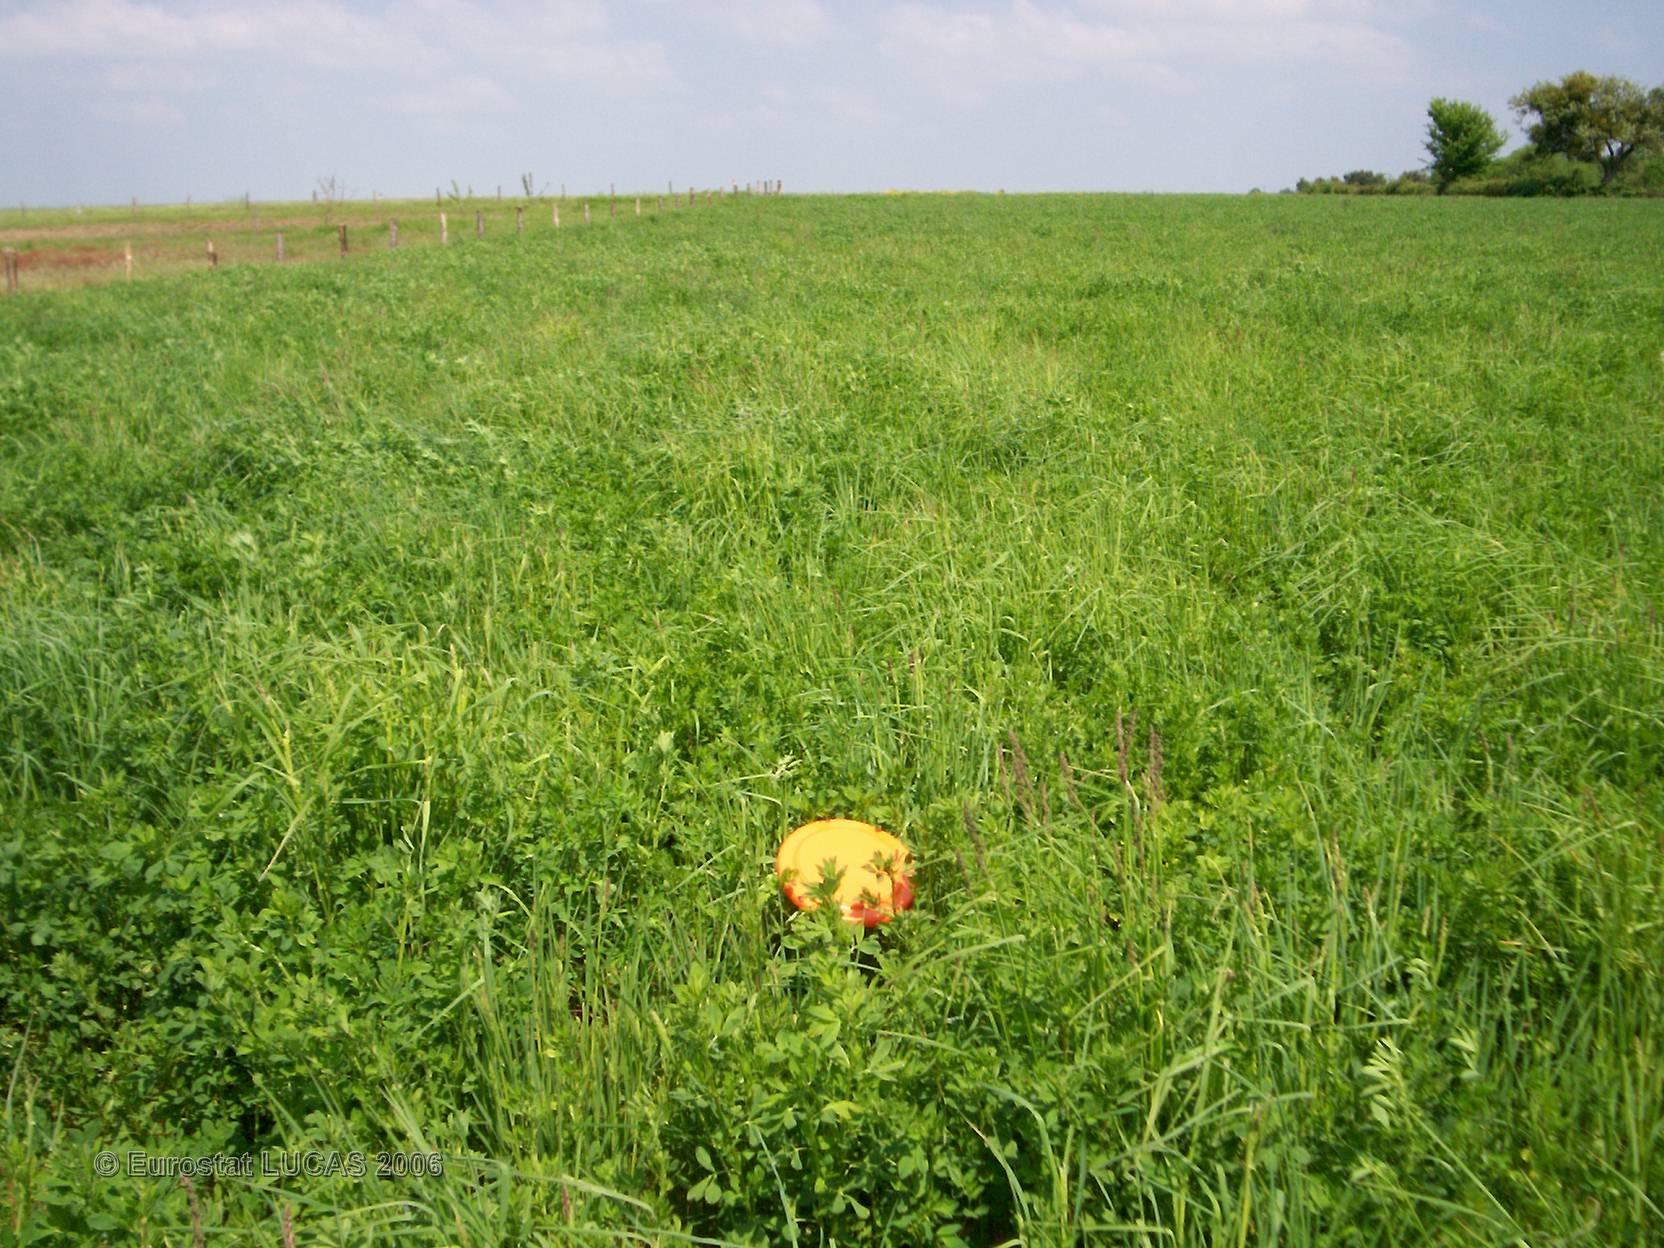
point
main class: Cropland
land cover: Lucerne
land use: Agriculture (excluding fallow land and kitchen gardens)
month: May
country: FR
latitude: 47.4822
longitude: 0.2490
